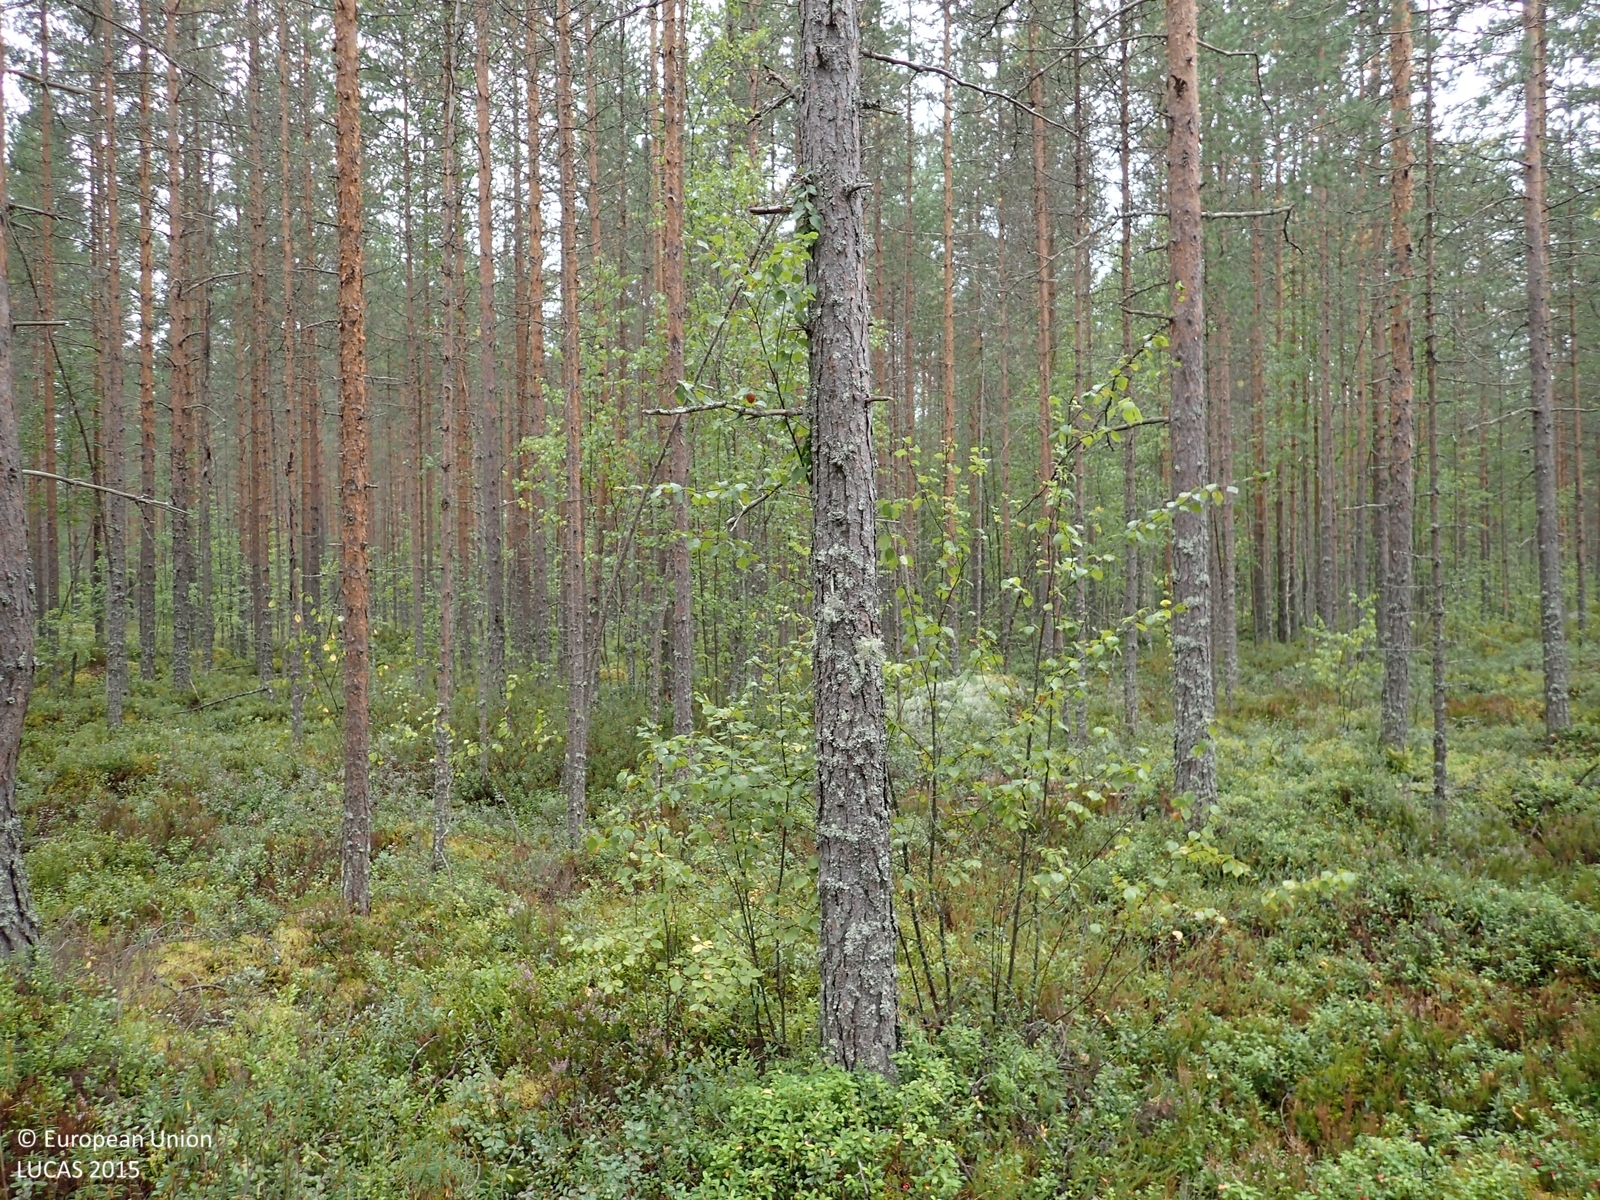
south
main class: Woodland
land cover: Pine dominated coniferous woodland
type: boreal forest
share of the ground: 50 - 75 %
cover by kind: coniferous forest trees 60 %, shrubs 25 %, lichens and mosses 10 %, broadleaved forest trees 5 %
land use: Forestry
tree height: > 5 m
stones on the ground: < 10 %
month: August
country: FI
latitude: 62.6692
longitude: 23.2039
